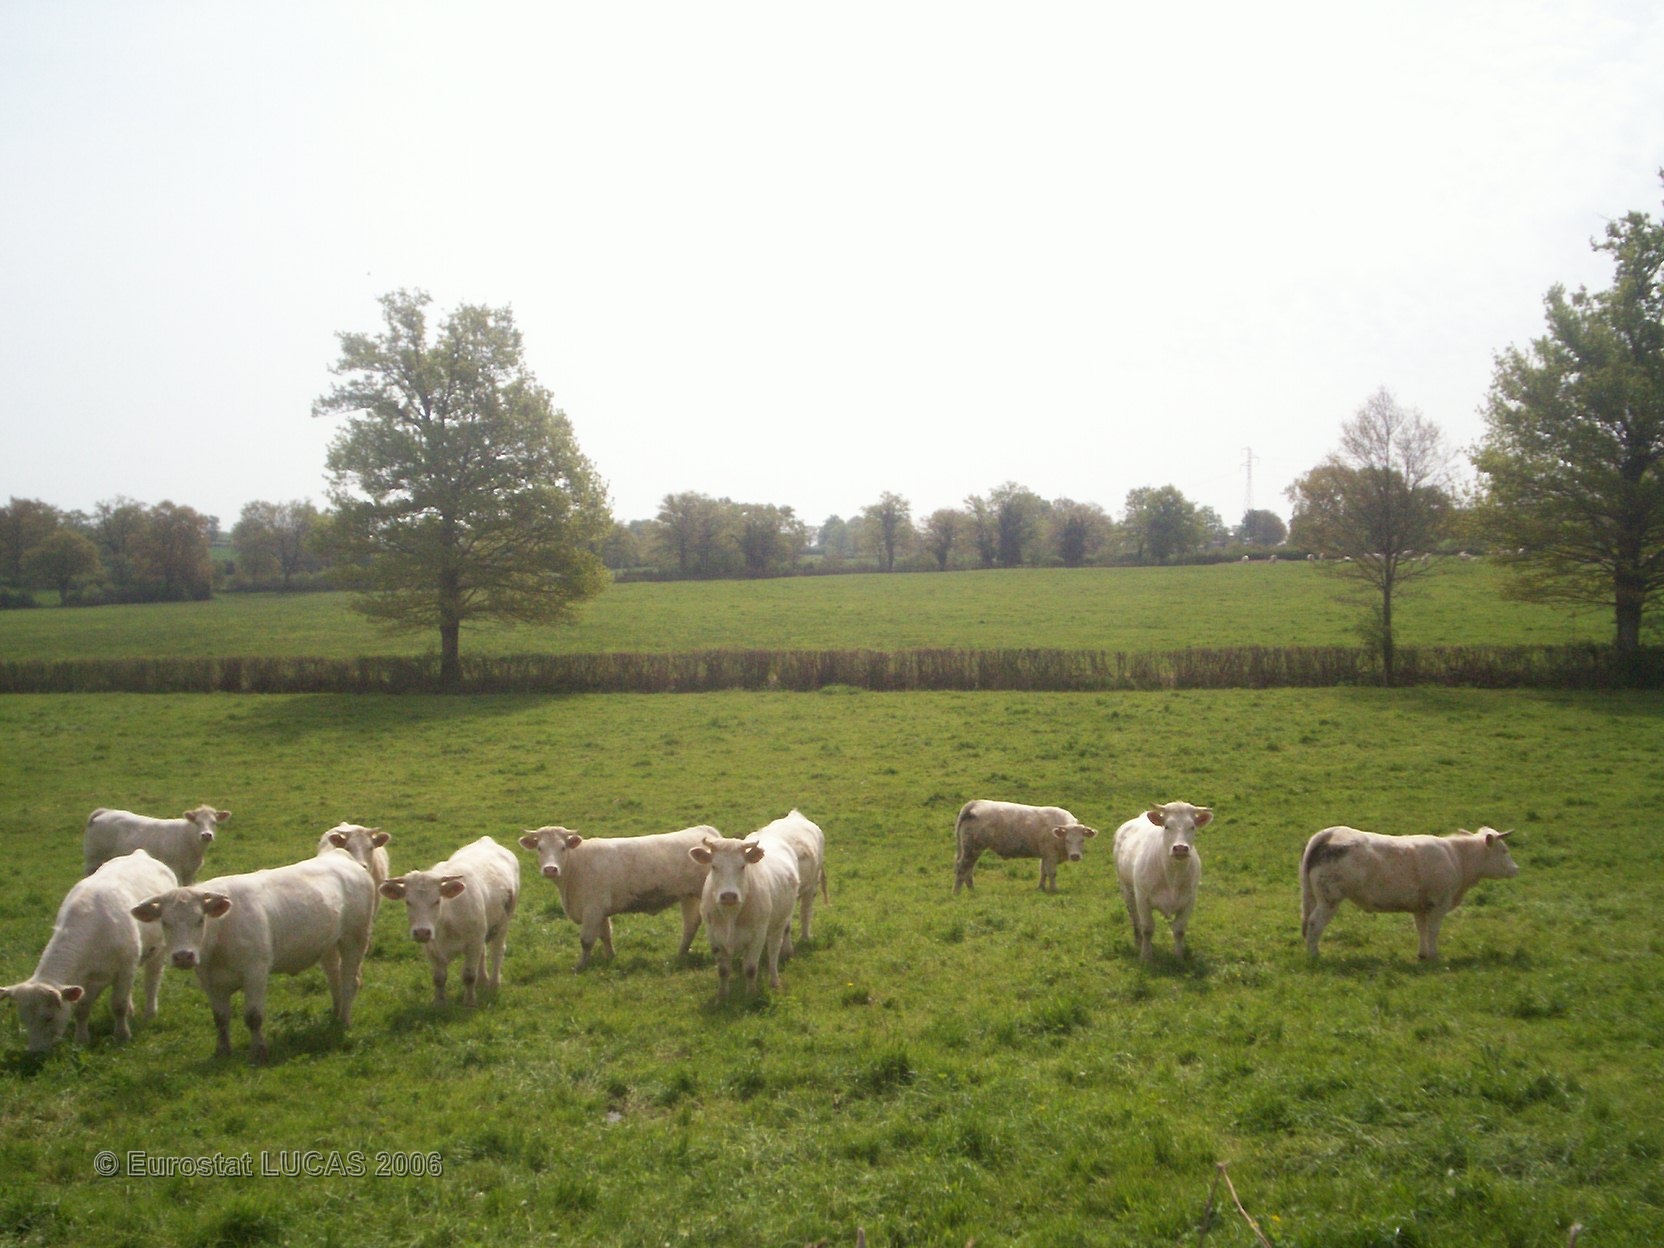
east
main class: Grassland
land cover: Grassland without tree/shrub cover
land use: Agriculture (excluding fallow land and kitchen gardens)
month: May
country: FR
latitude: 46.5635
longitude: 3.1225
